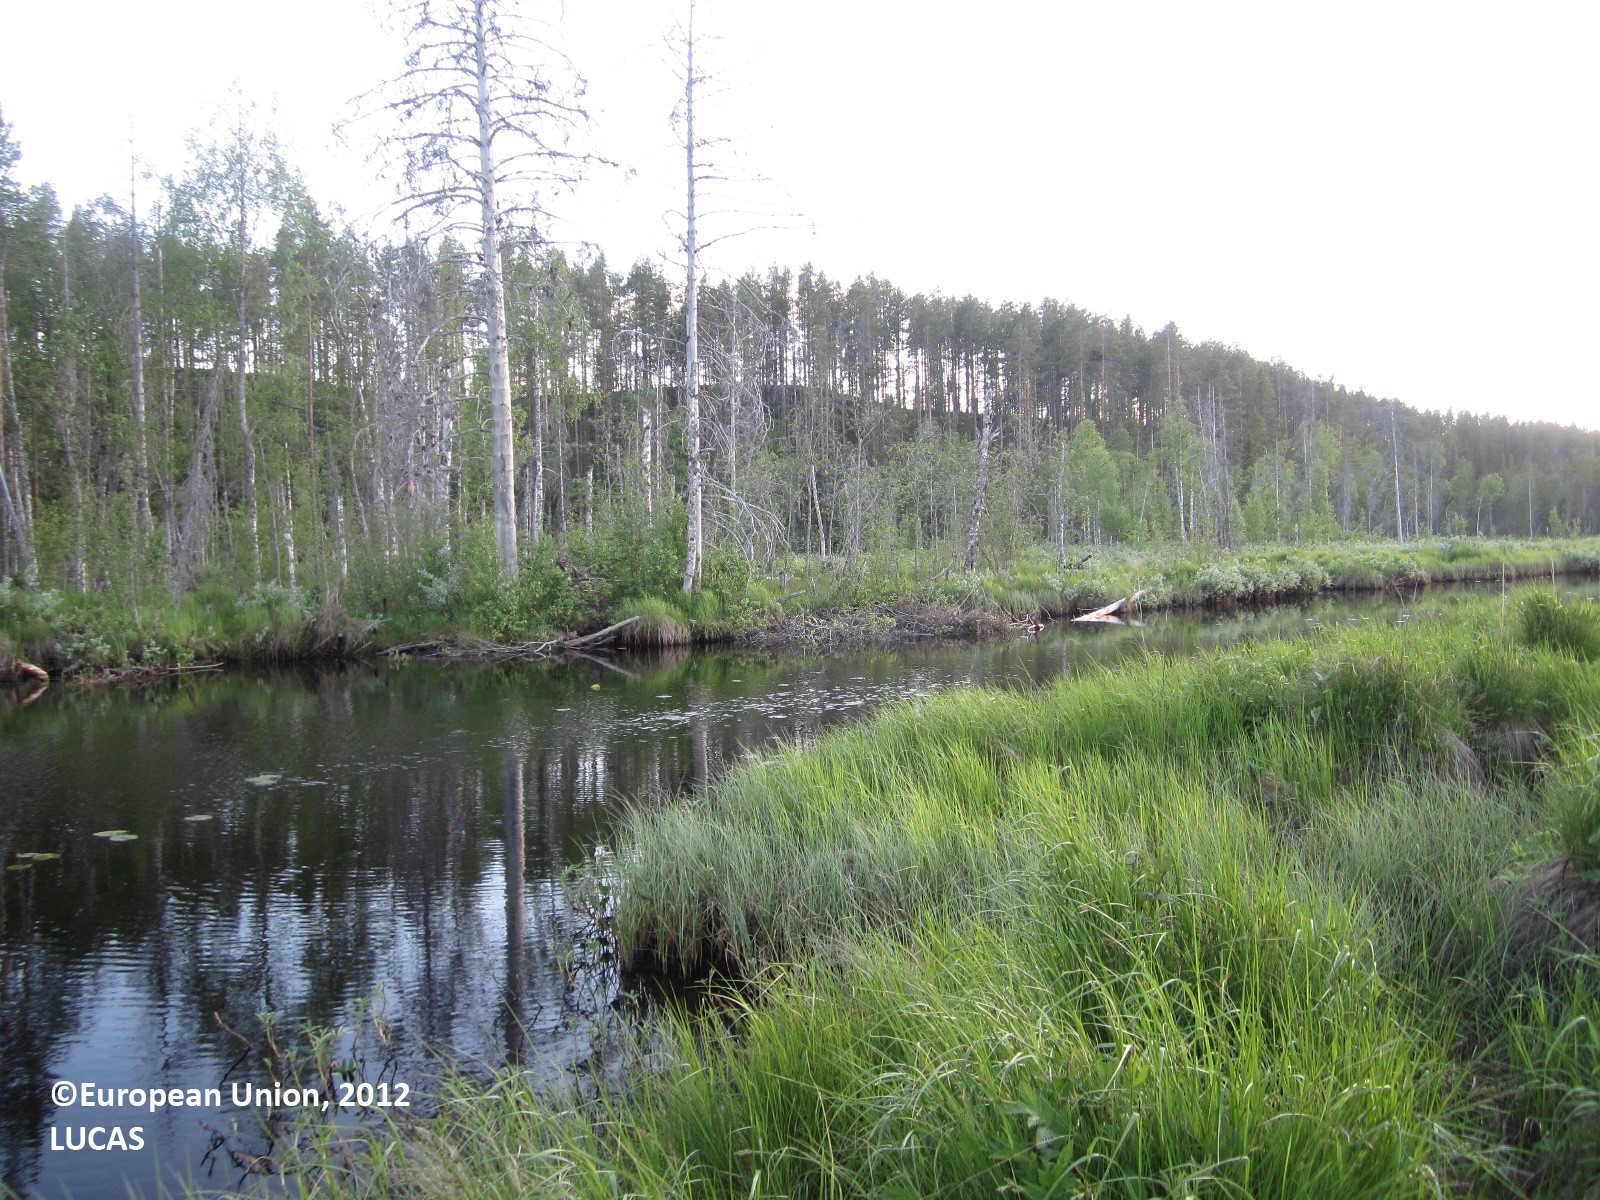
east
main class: Woodland
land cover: Pine dominated coniferous woodland
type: boreal forest
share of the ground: > 75 %
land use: Forestry
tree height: > 5 m
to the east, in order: Pine dominated coniferous woodland; Inland water bodies
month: June
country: FI
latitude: 64.8277
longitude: 29.2689
